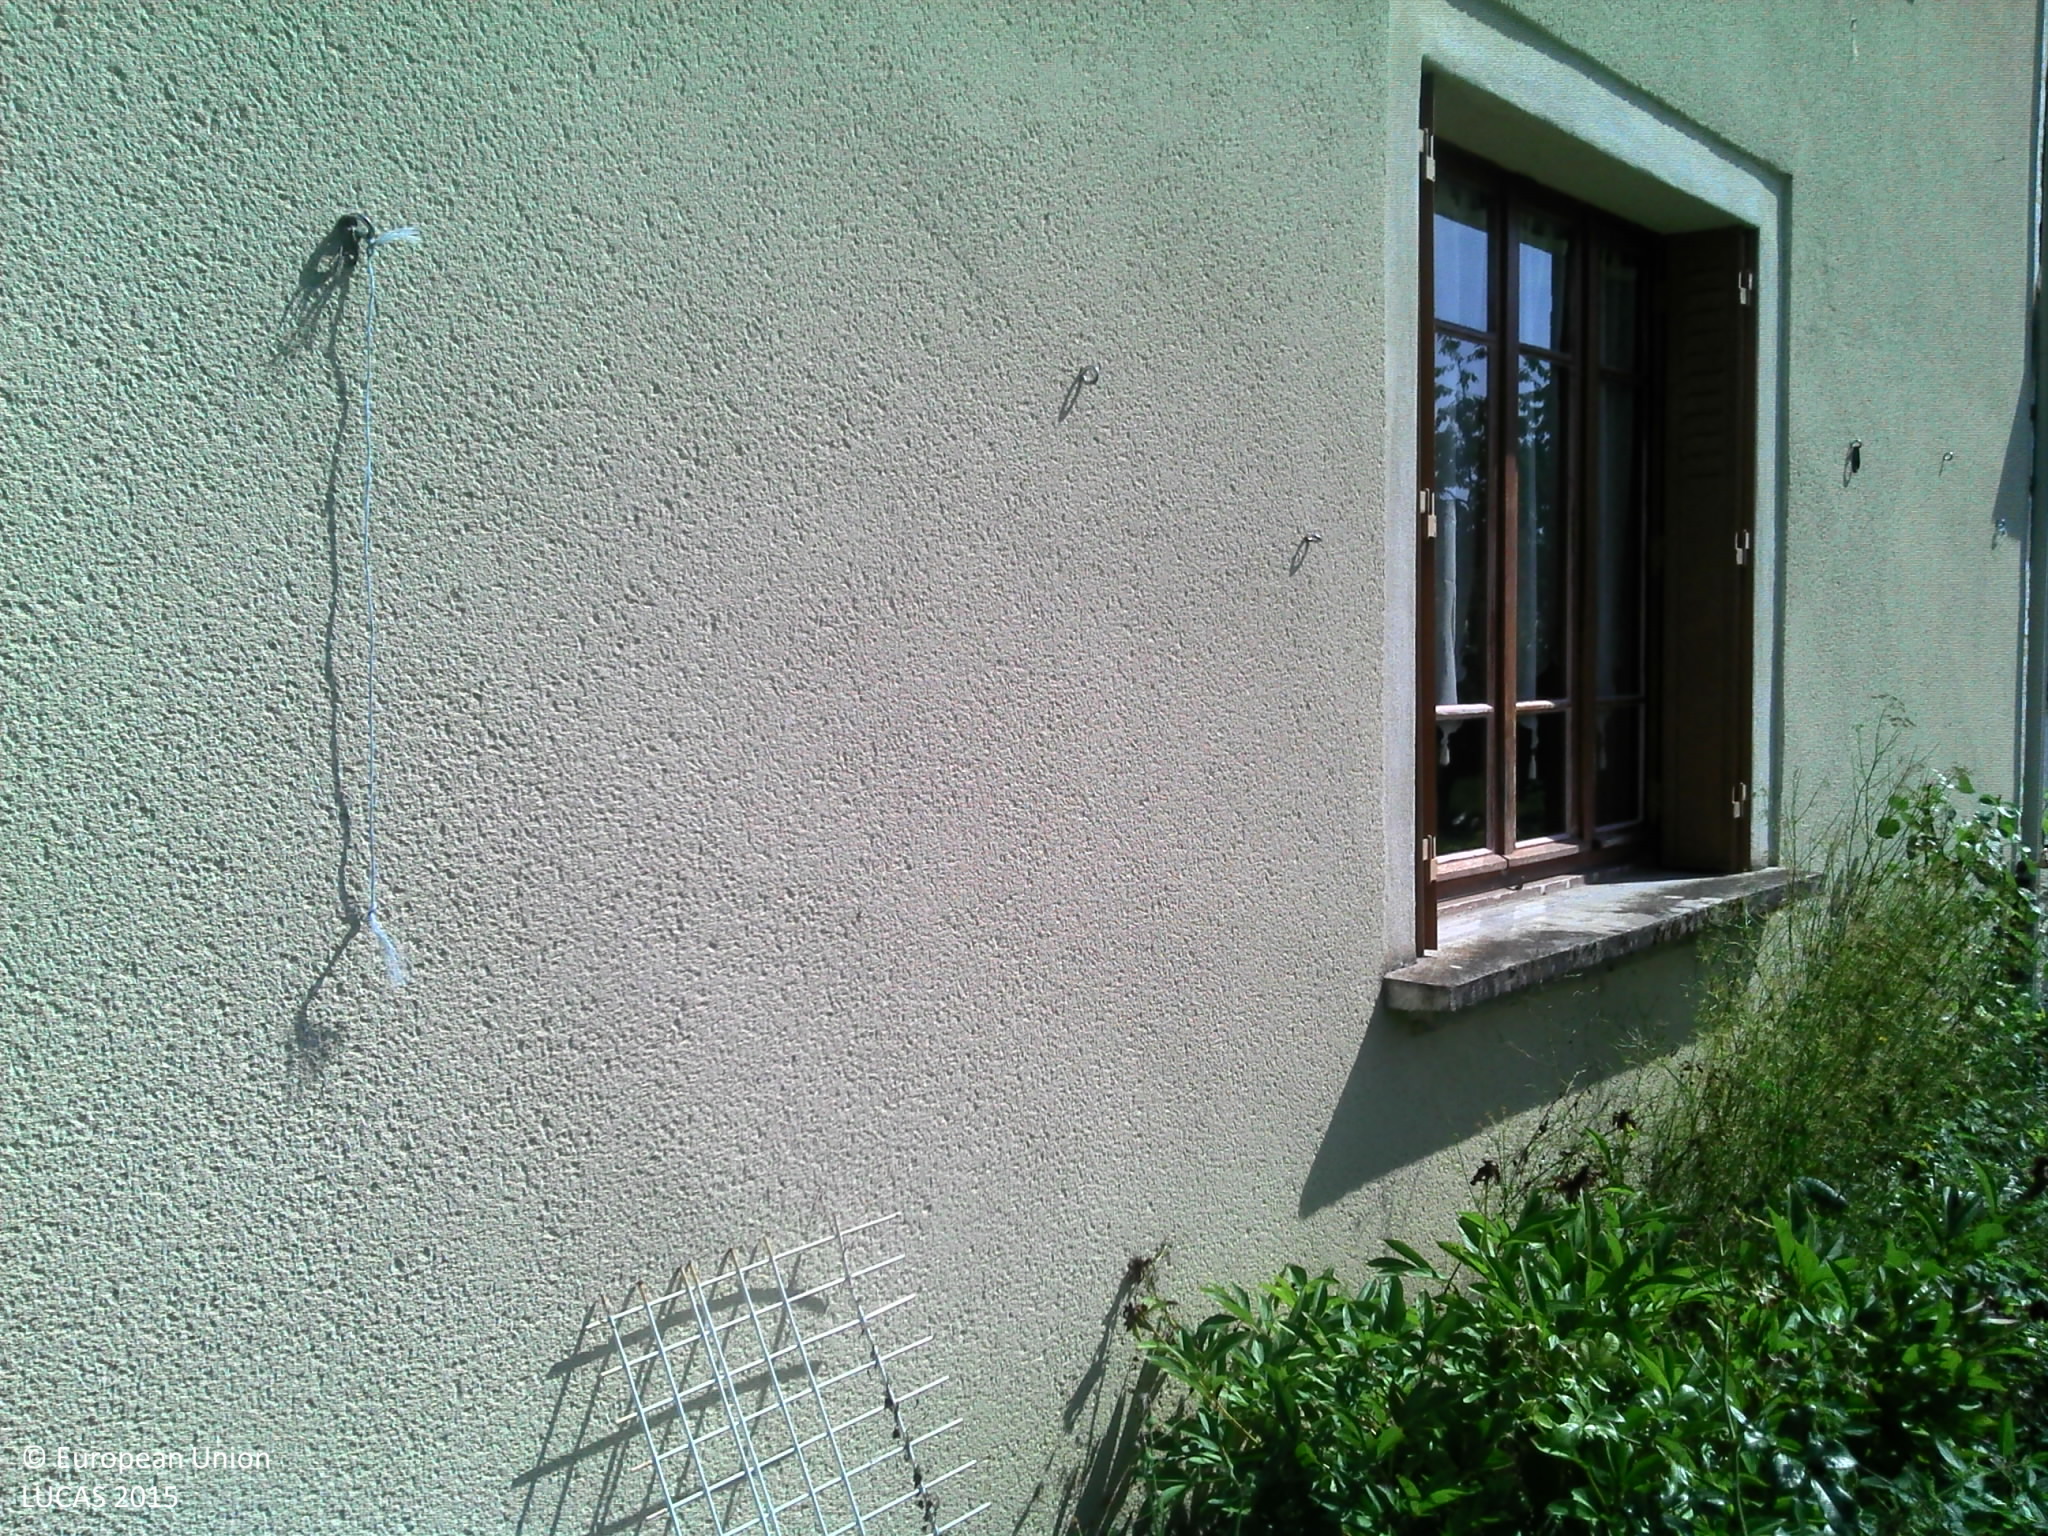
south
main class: Grassland
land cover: Grassland without tree/shrub cover
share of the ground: > 75 %
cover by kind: herbaceous plants 100 %
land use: Residential
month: August
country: FR
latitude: 44.3813
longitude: 1.2743
